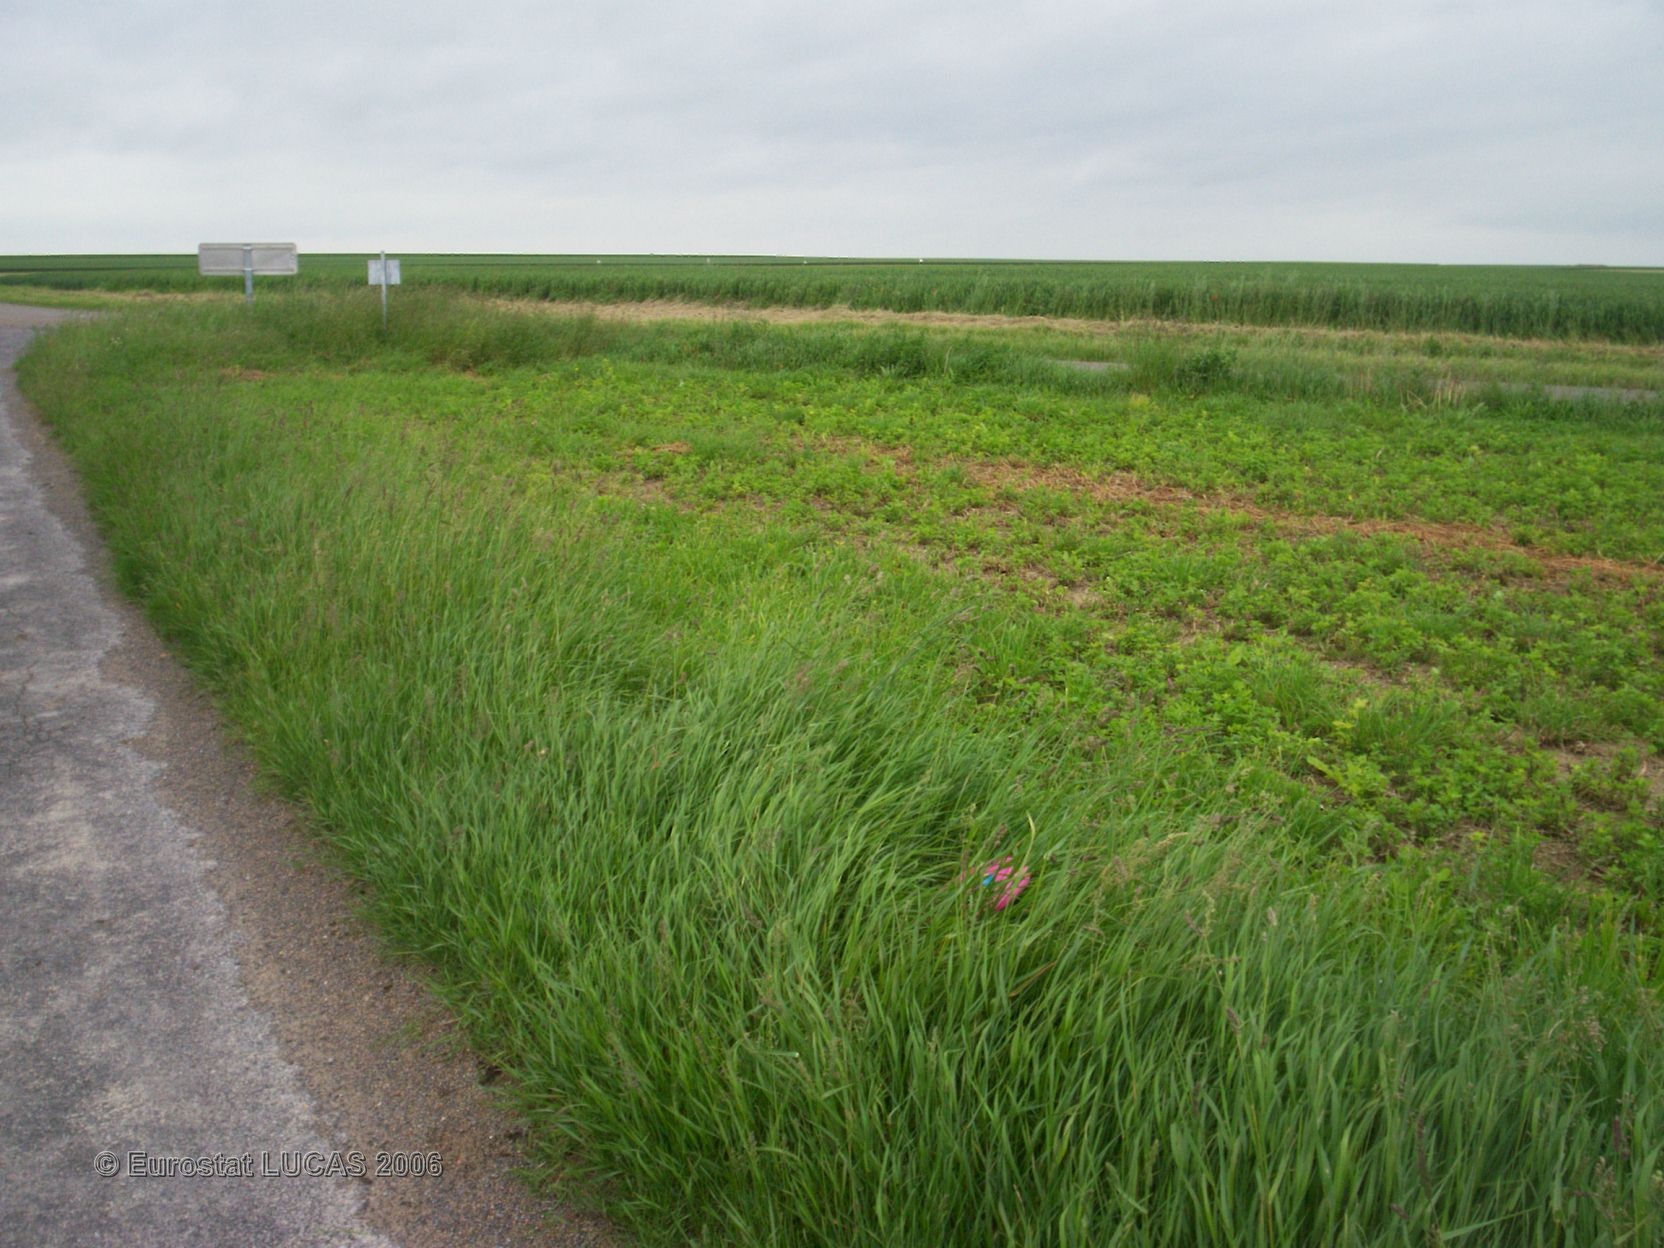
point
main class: Cropland
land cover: Lucerne
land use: Agriculture (excluding fallow land and kitchen gardens)
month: May
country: FR
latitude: 49.3074
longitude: 4.3983
